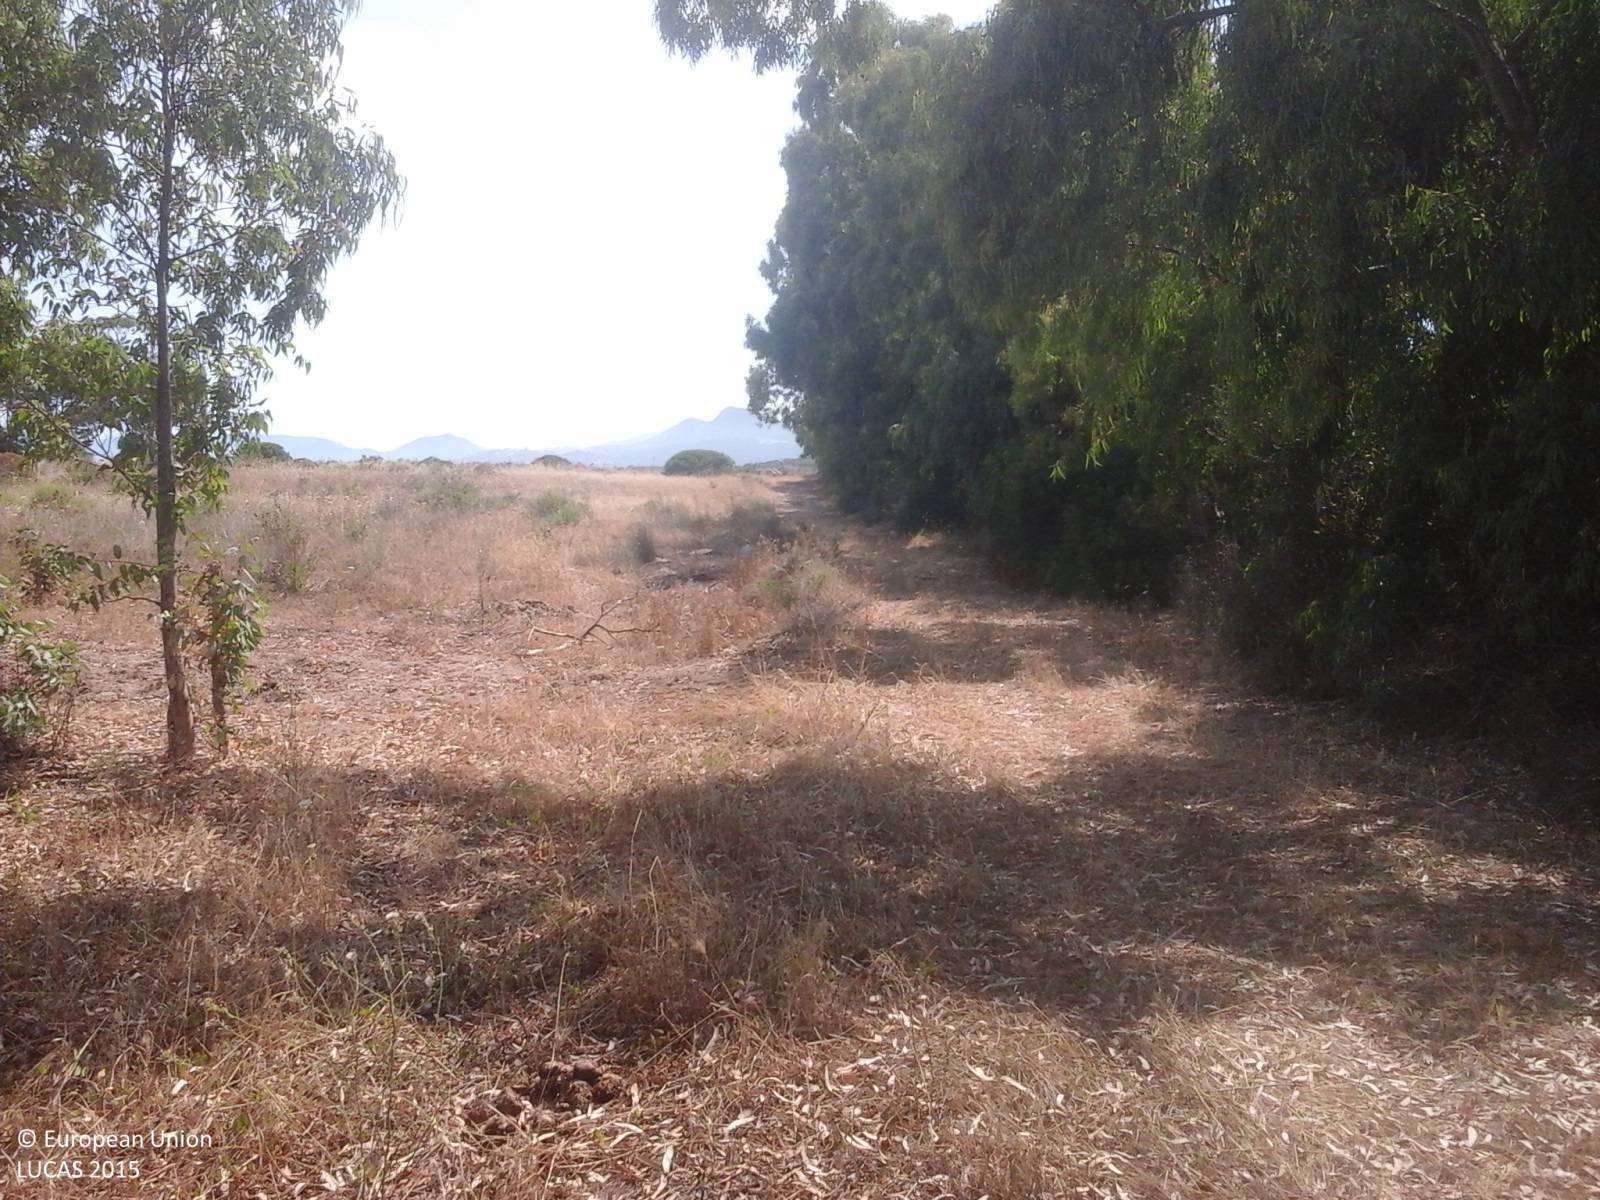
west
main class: Cropland
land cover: Common wheat
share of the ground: > 75 %
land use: Agriculture (excluding fallow land and kitchen gardens)
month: June
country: IT
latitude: 39.2885
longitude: 9.5967
